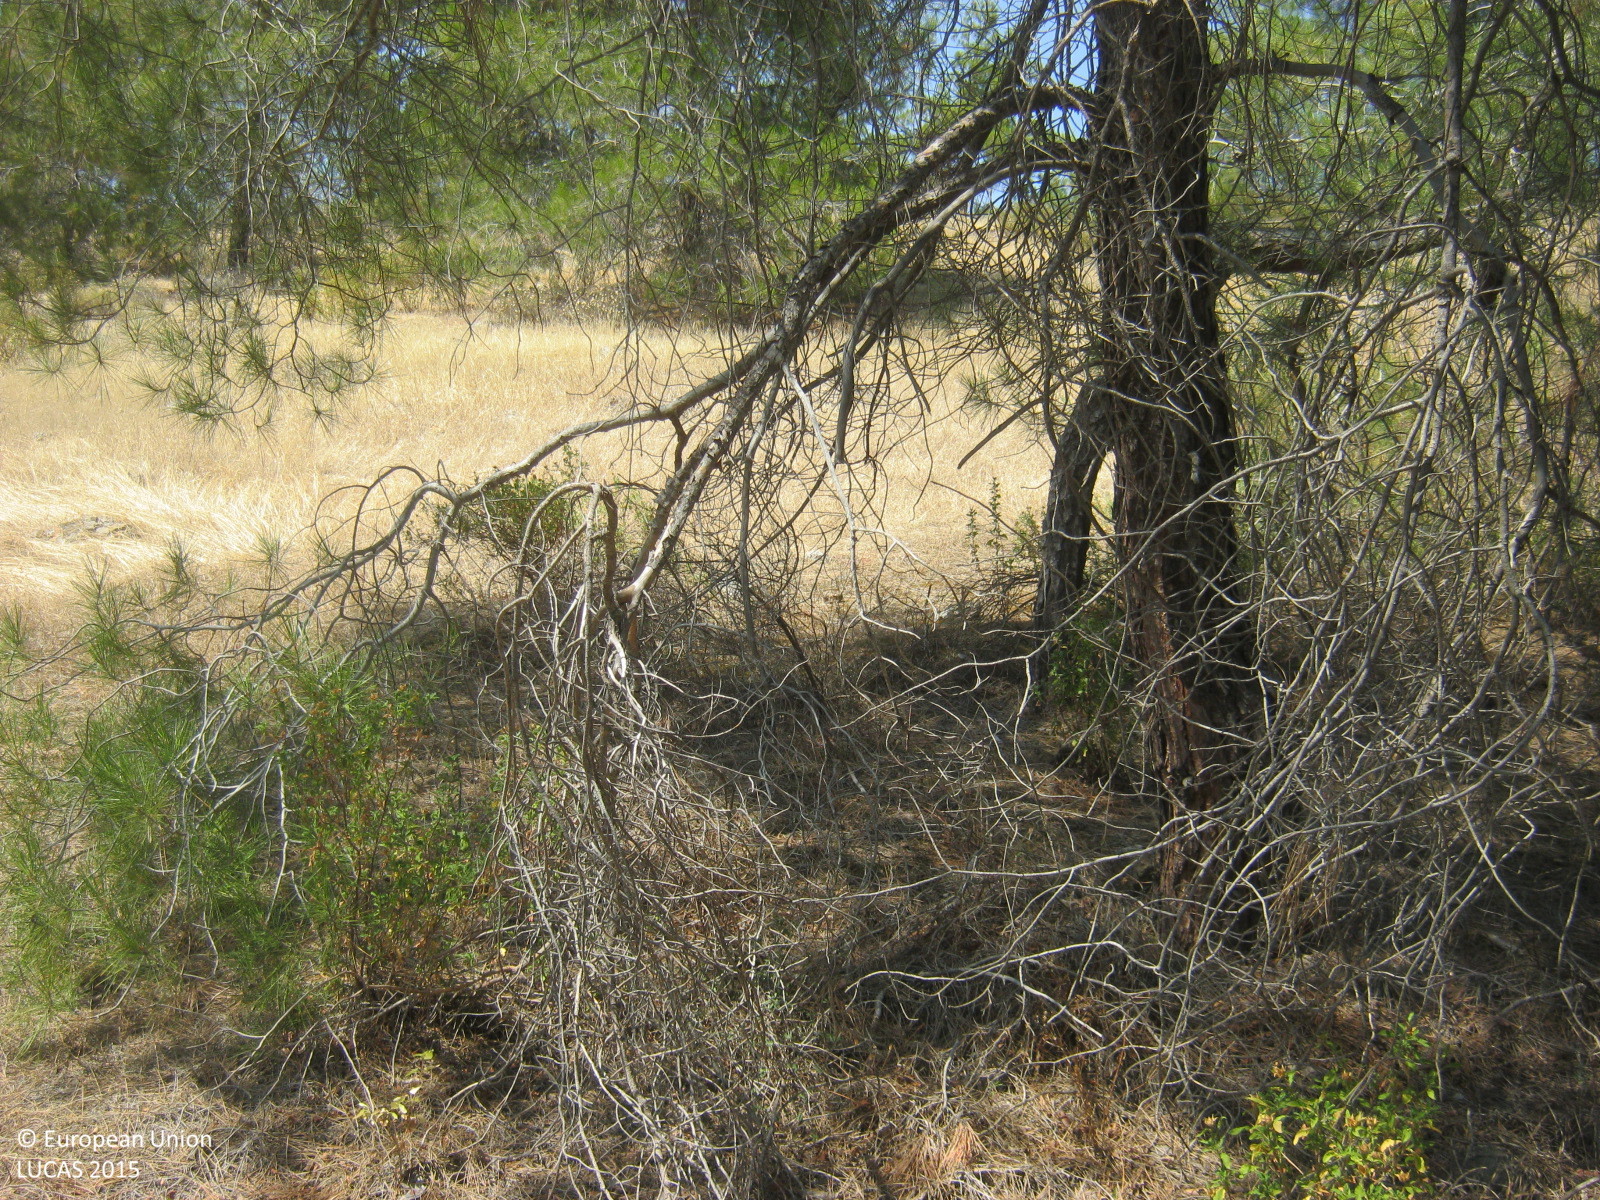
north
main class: Woodland
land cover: Pine dominated coniferous woodland
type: coniferous forest of the mediterranean region
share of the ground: 50 - 75 %
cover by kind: coniferous forest trees 70 %, shrubs 20 %, unconsolidated bare surface 10 %
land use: Forestry
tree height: > 5 m
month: June
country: CY
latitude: 35.0033
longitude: 33.1346
